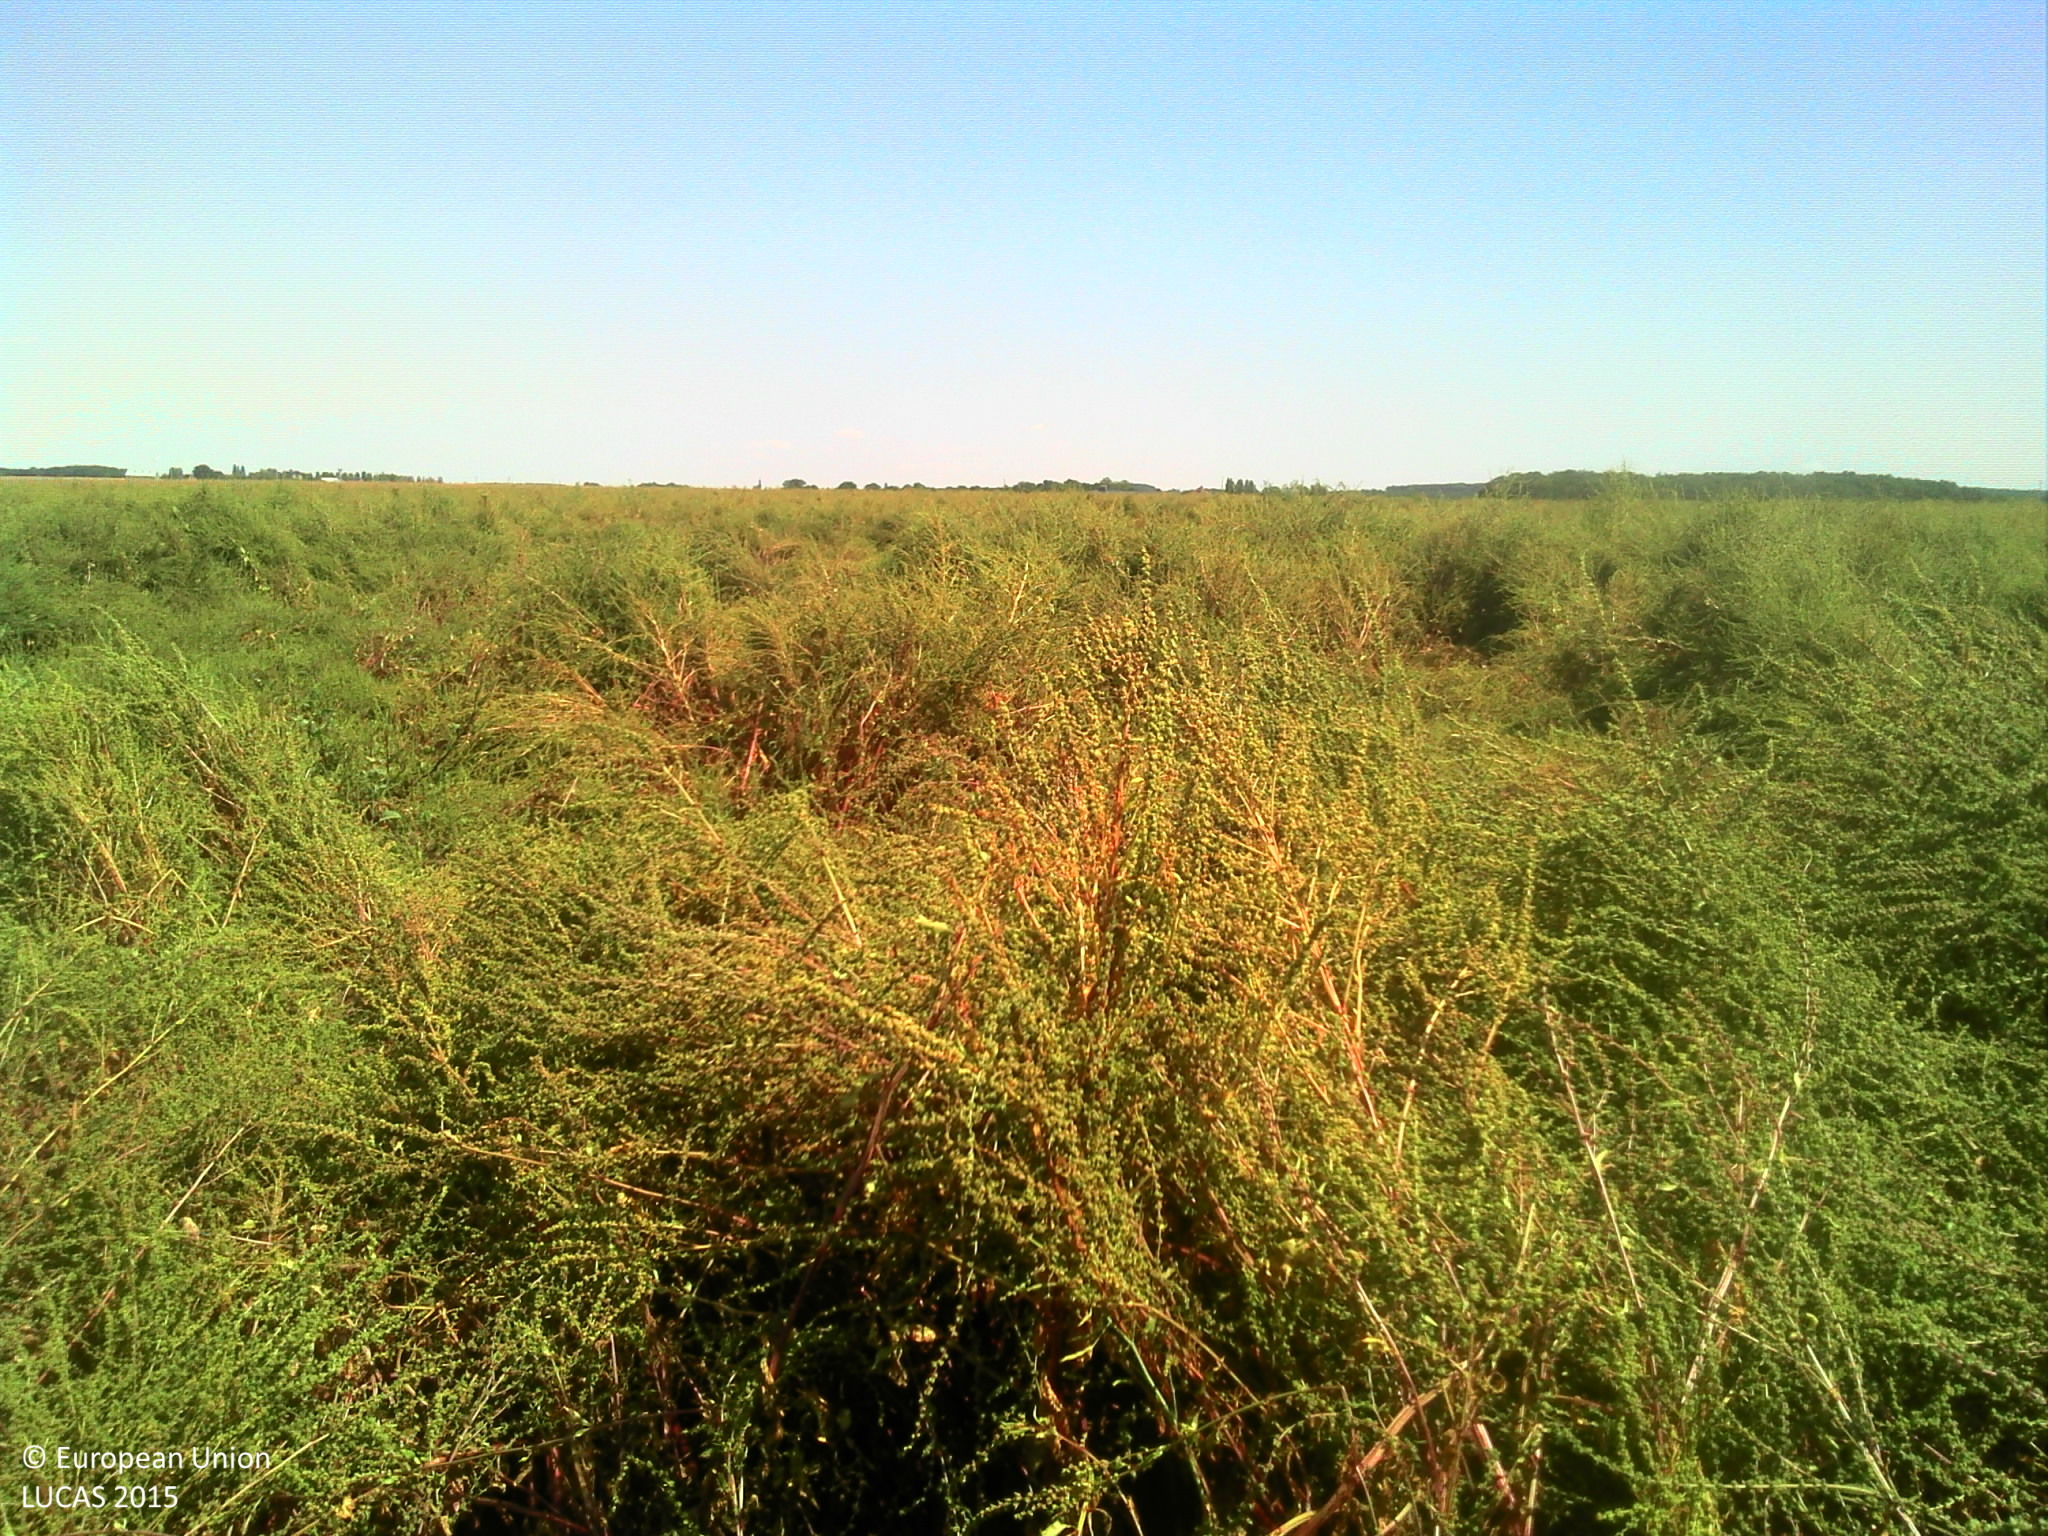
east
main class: Cropland
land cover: Sugar beet
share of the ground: > 75 %
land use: Agriculture (excluding fallow land and kitchen gardens)
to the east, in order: Sugar beet; Rape and turnip rape; Common wheat
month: July
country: FR
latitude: 48.2030
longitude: 1.2767
